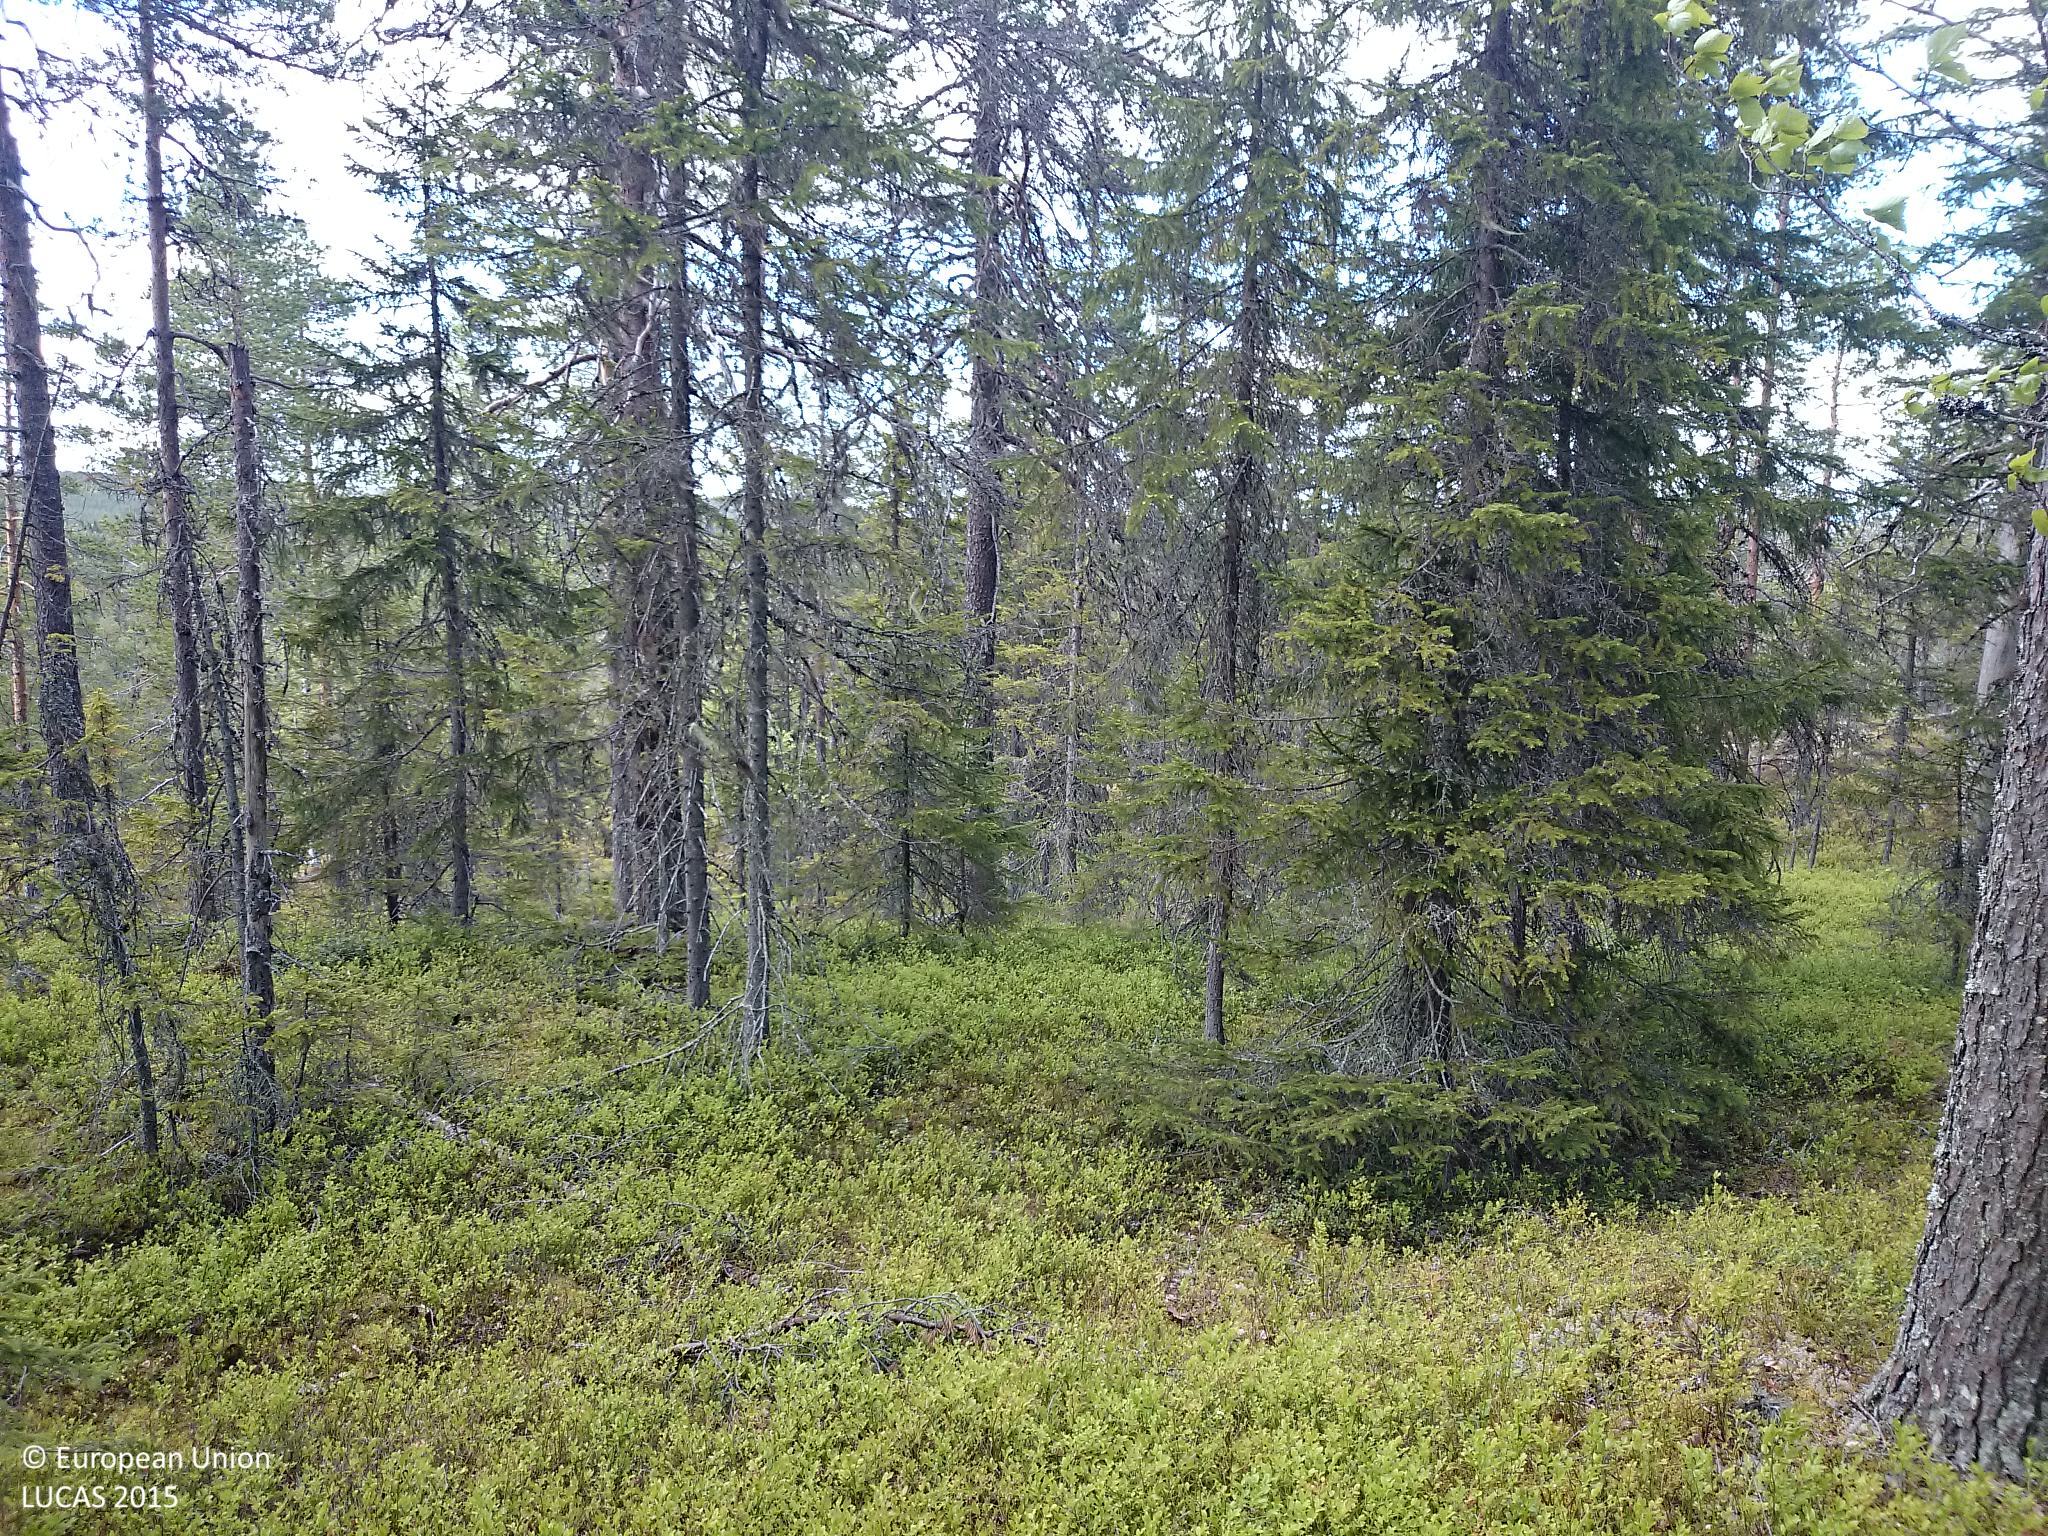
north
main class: Woodland
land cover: Other coniferous woodland
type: boreal forest
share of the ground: 25 - 50 %
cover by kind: coniferous forest trees 50 %, shrubs 40 %, lichens and mosses 5 %, consolidated bare surface 5 %
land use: Forestry
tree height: > 5 m
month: June
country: SE
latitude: 64.1451
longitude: 20.1517
